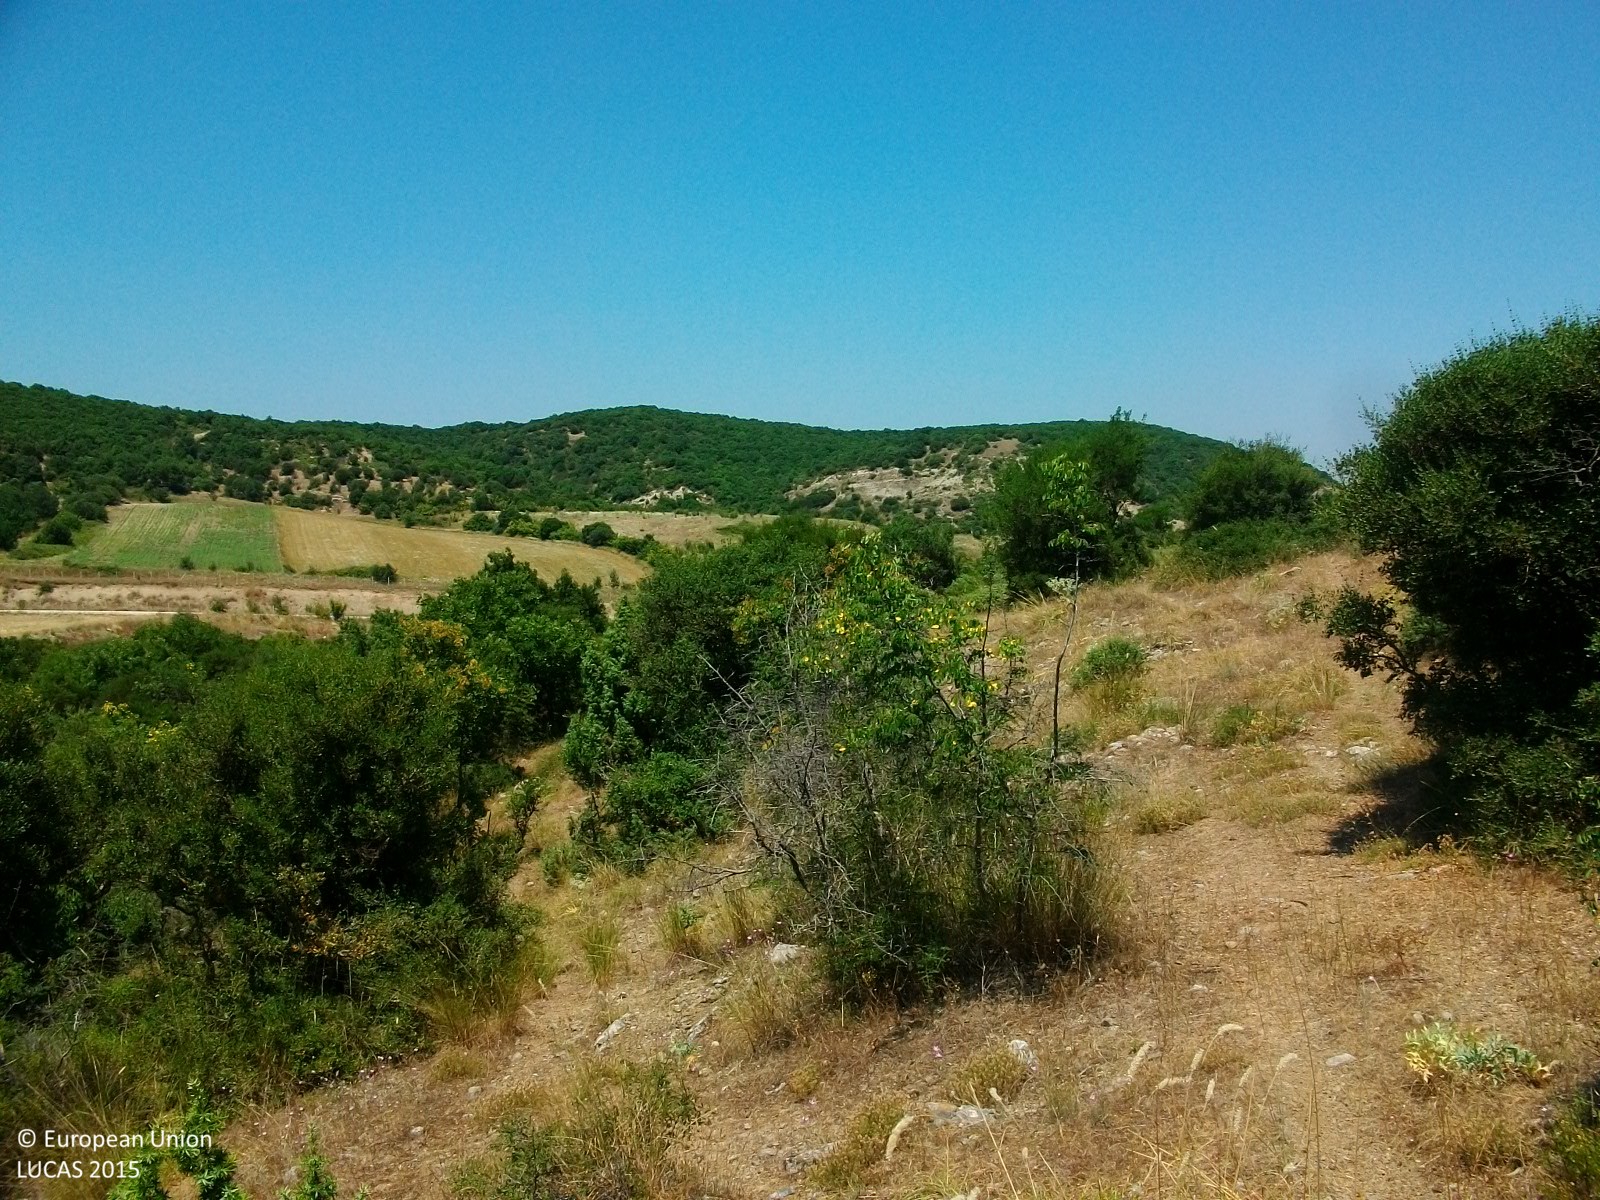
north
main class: Shrubland
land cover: Shrubland with sparse tree cover
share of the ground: 50 - 75 %
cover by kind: shrubs 70 %, herbaceous plants 25 %, broadleaved forest trees 5 %
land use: Semi-natural and natural areas not in use
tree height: < 5 m
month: July
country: GR
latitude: 40.9245
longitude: 26.1534
